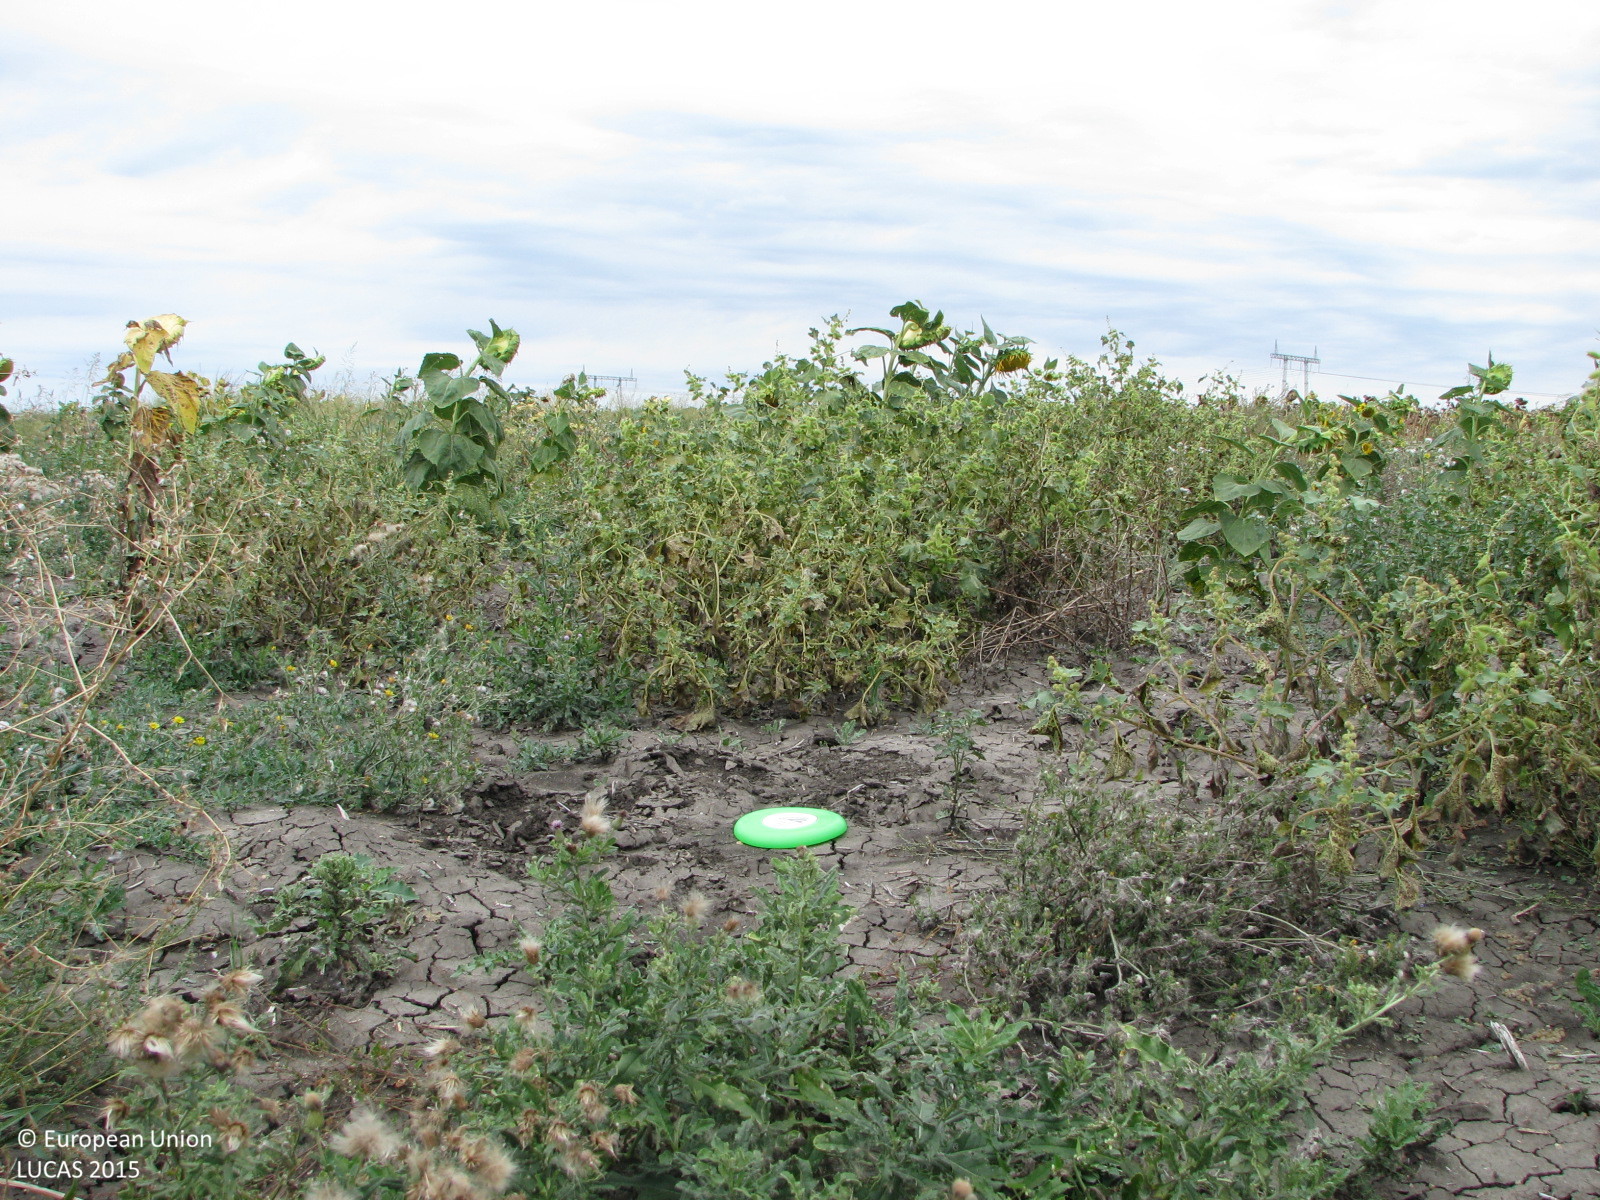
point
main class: Cropland
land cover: Sunflower
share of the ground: 25 - 50 %
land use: Agriculture (excluding fallow land and kitchen gardens)
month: September
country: BG
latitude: 42.3283
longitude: 26.1120
